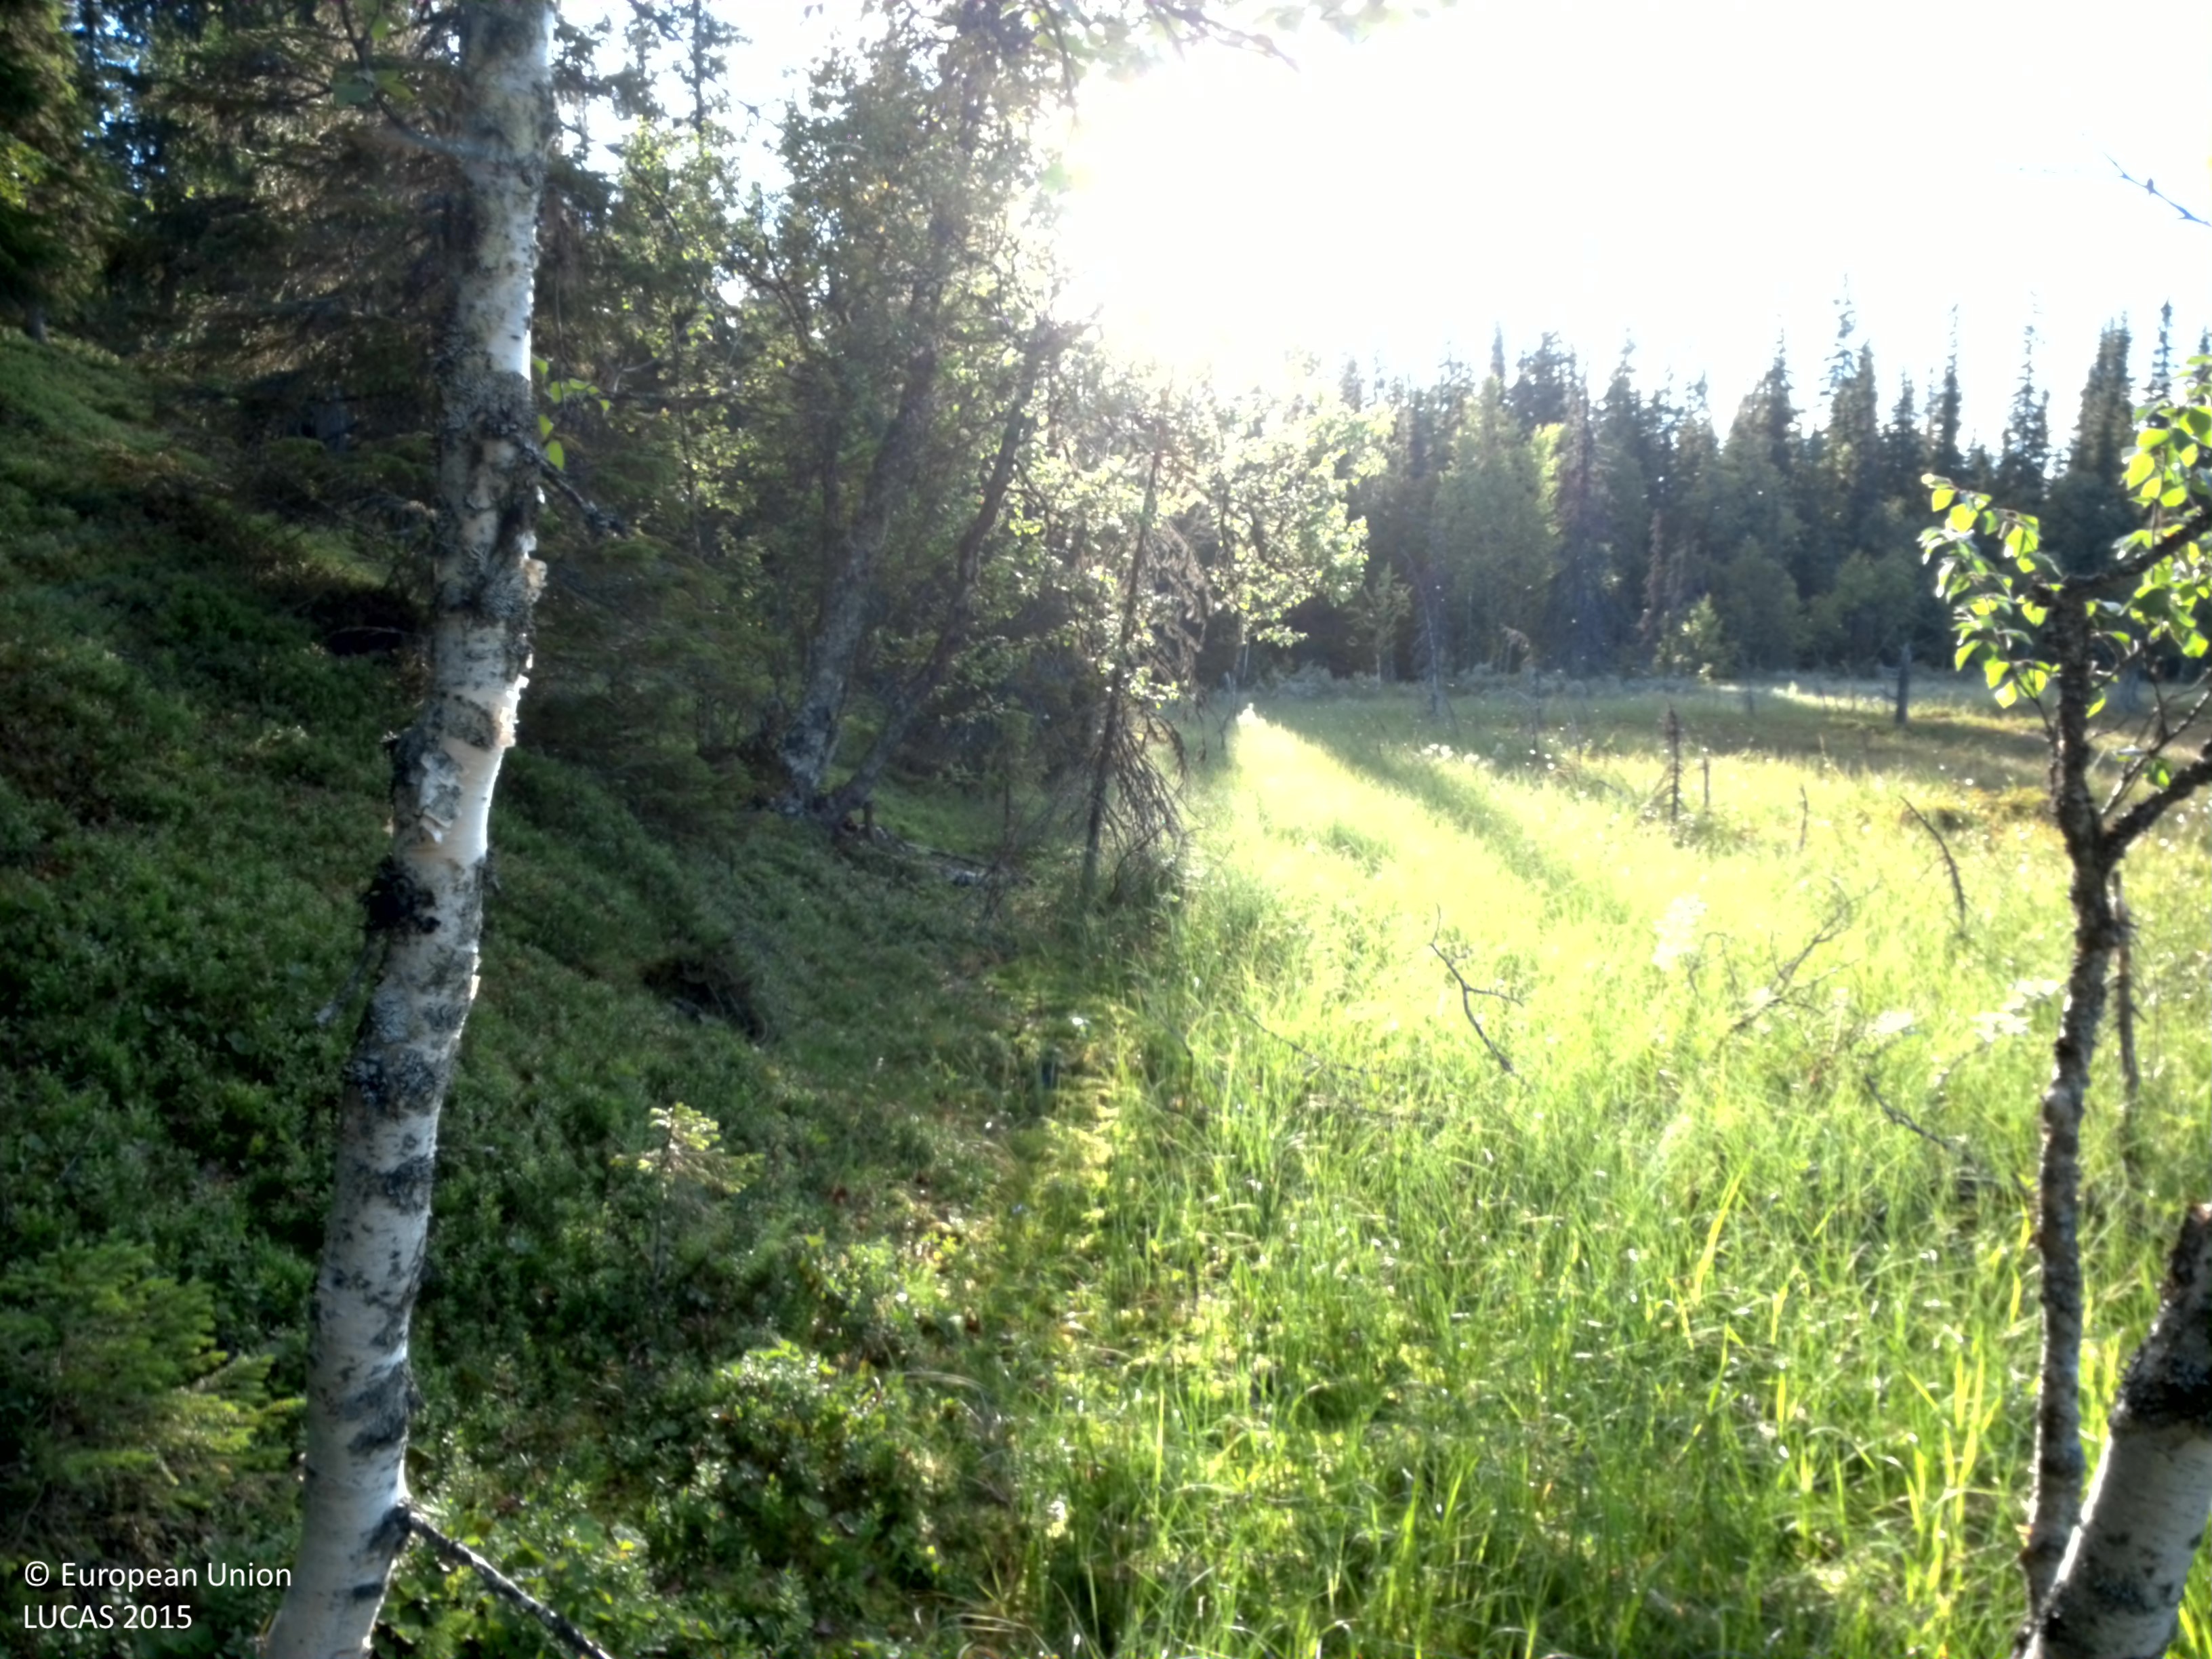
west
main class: Shrubland
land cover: Shrubland with sparse tree cover
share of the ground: 25 - 50 %
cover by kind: herbaceous plants 45 %, lichens and mosses 30 %, shrubs 20 %, broadleaved forest trees 5 %
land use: Semi-natural and natural areas not in use
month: August
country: SE
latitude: 64.8995
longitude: 15.5244
